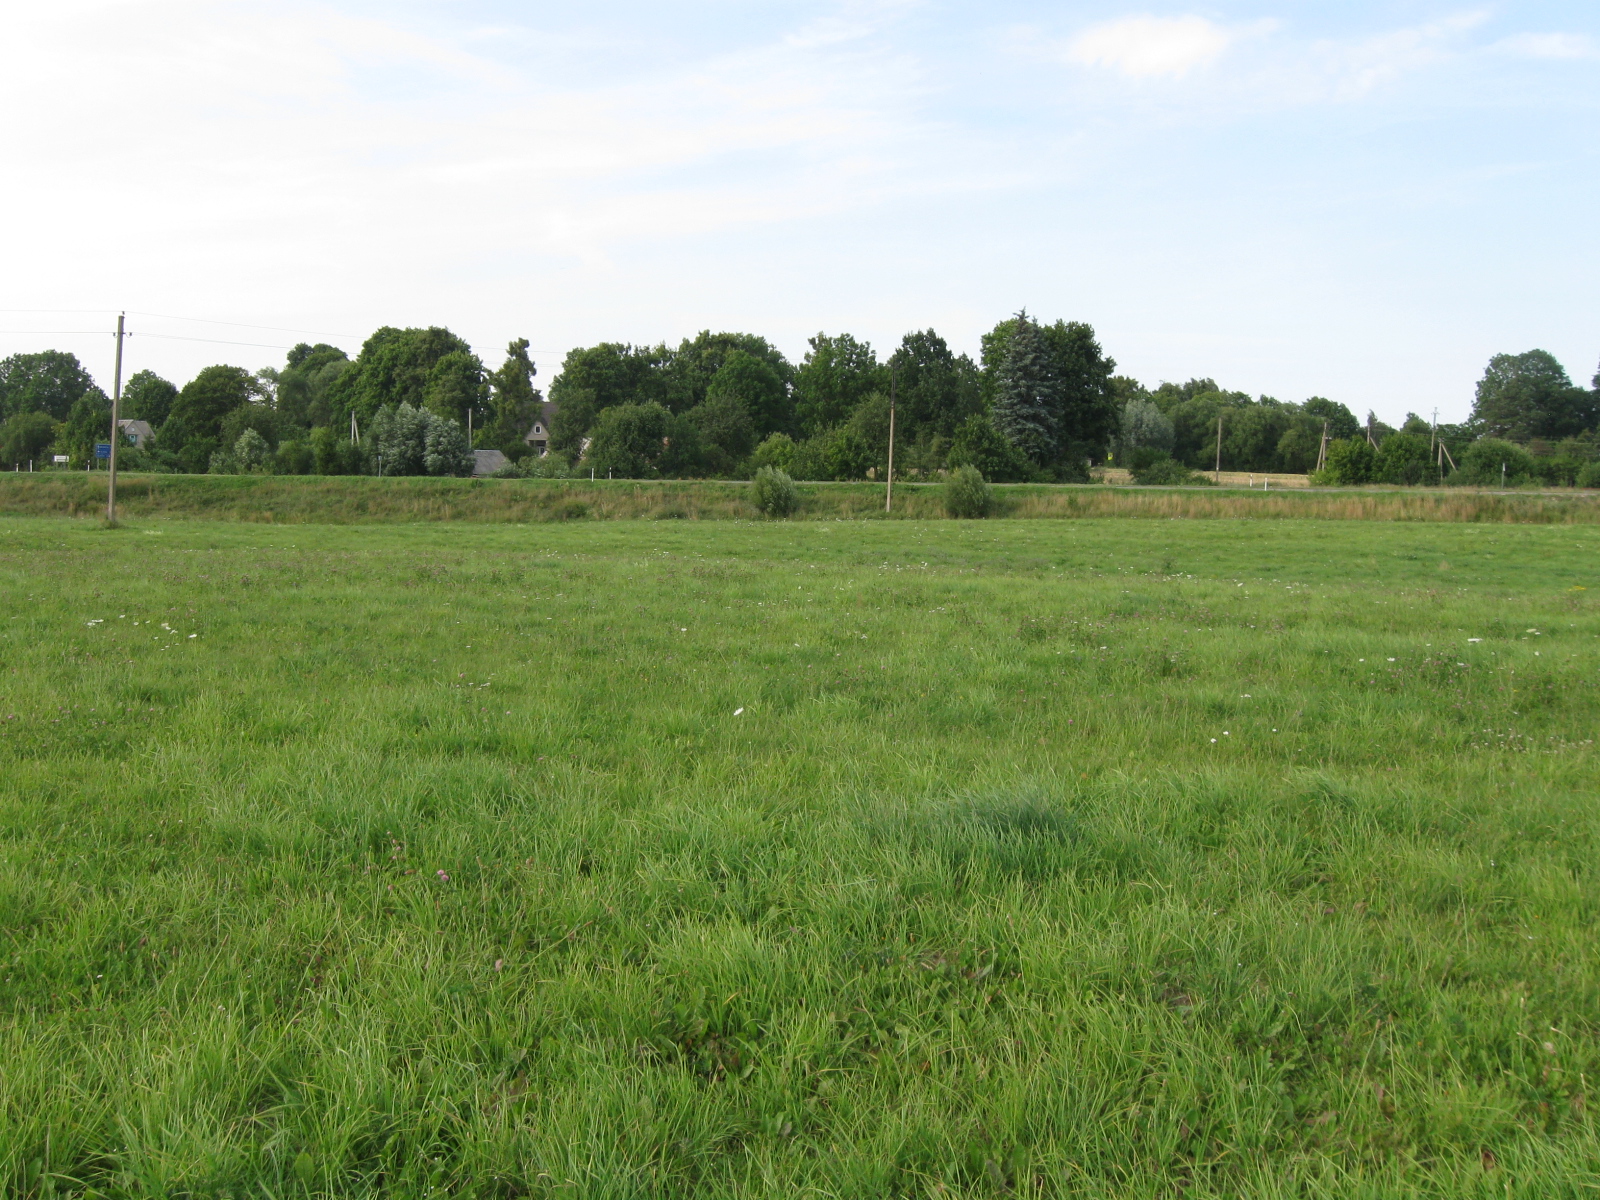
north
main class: Grassland
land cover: Grassland without tree/shrub cover
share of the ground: > 75 %
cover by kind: herbaceous plants 100 %
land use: Agriculture (excluding fallow land and kitchen gardens)
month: July
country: LT
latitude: 54.6654
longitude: 23.8405
